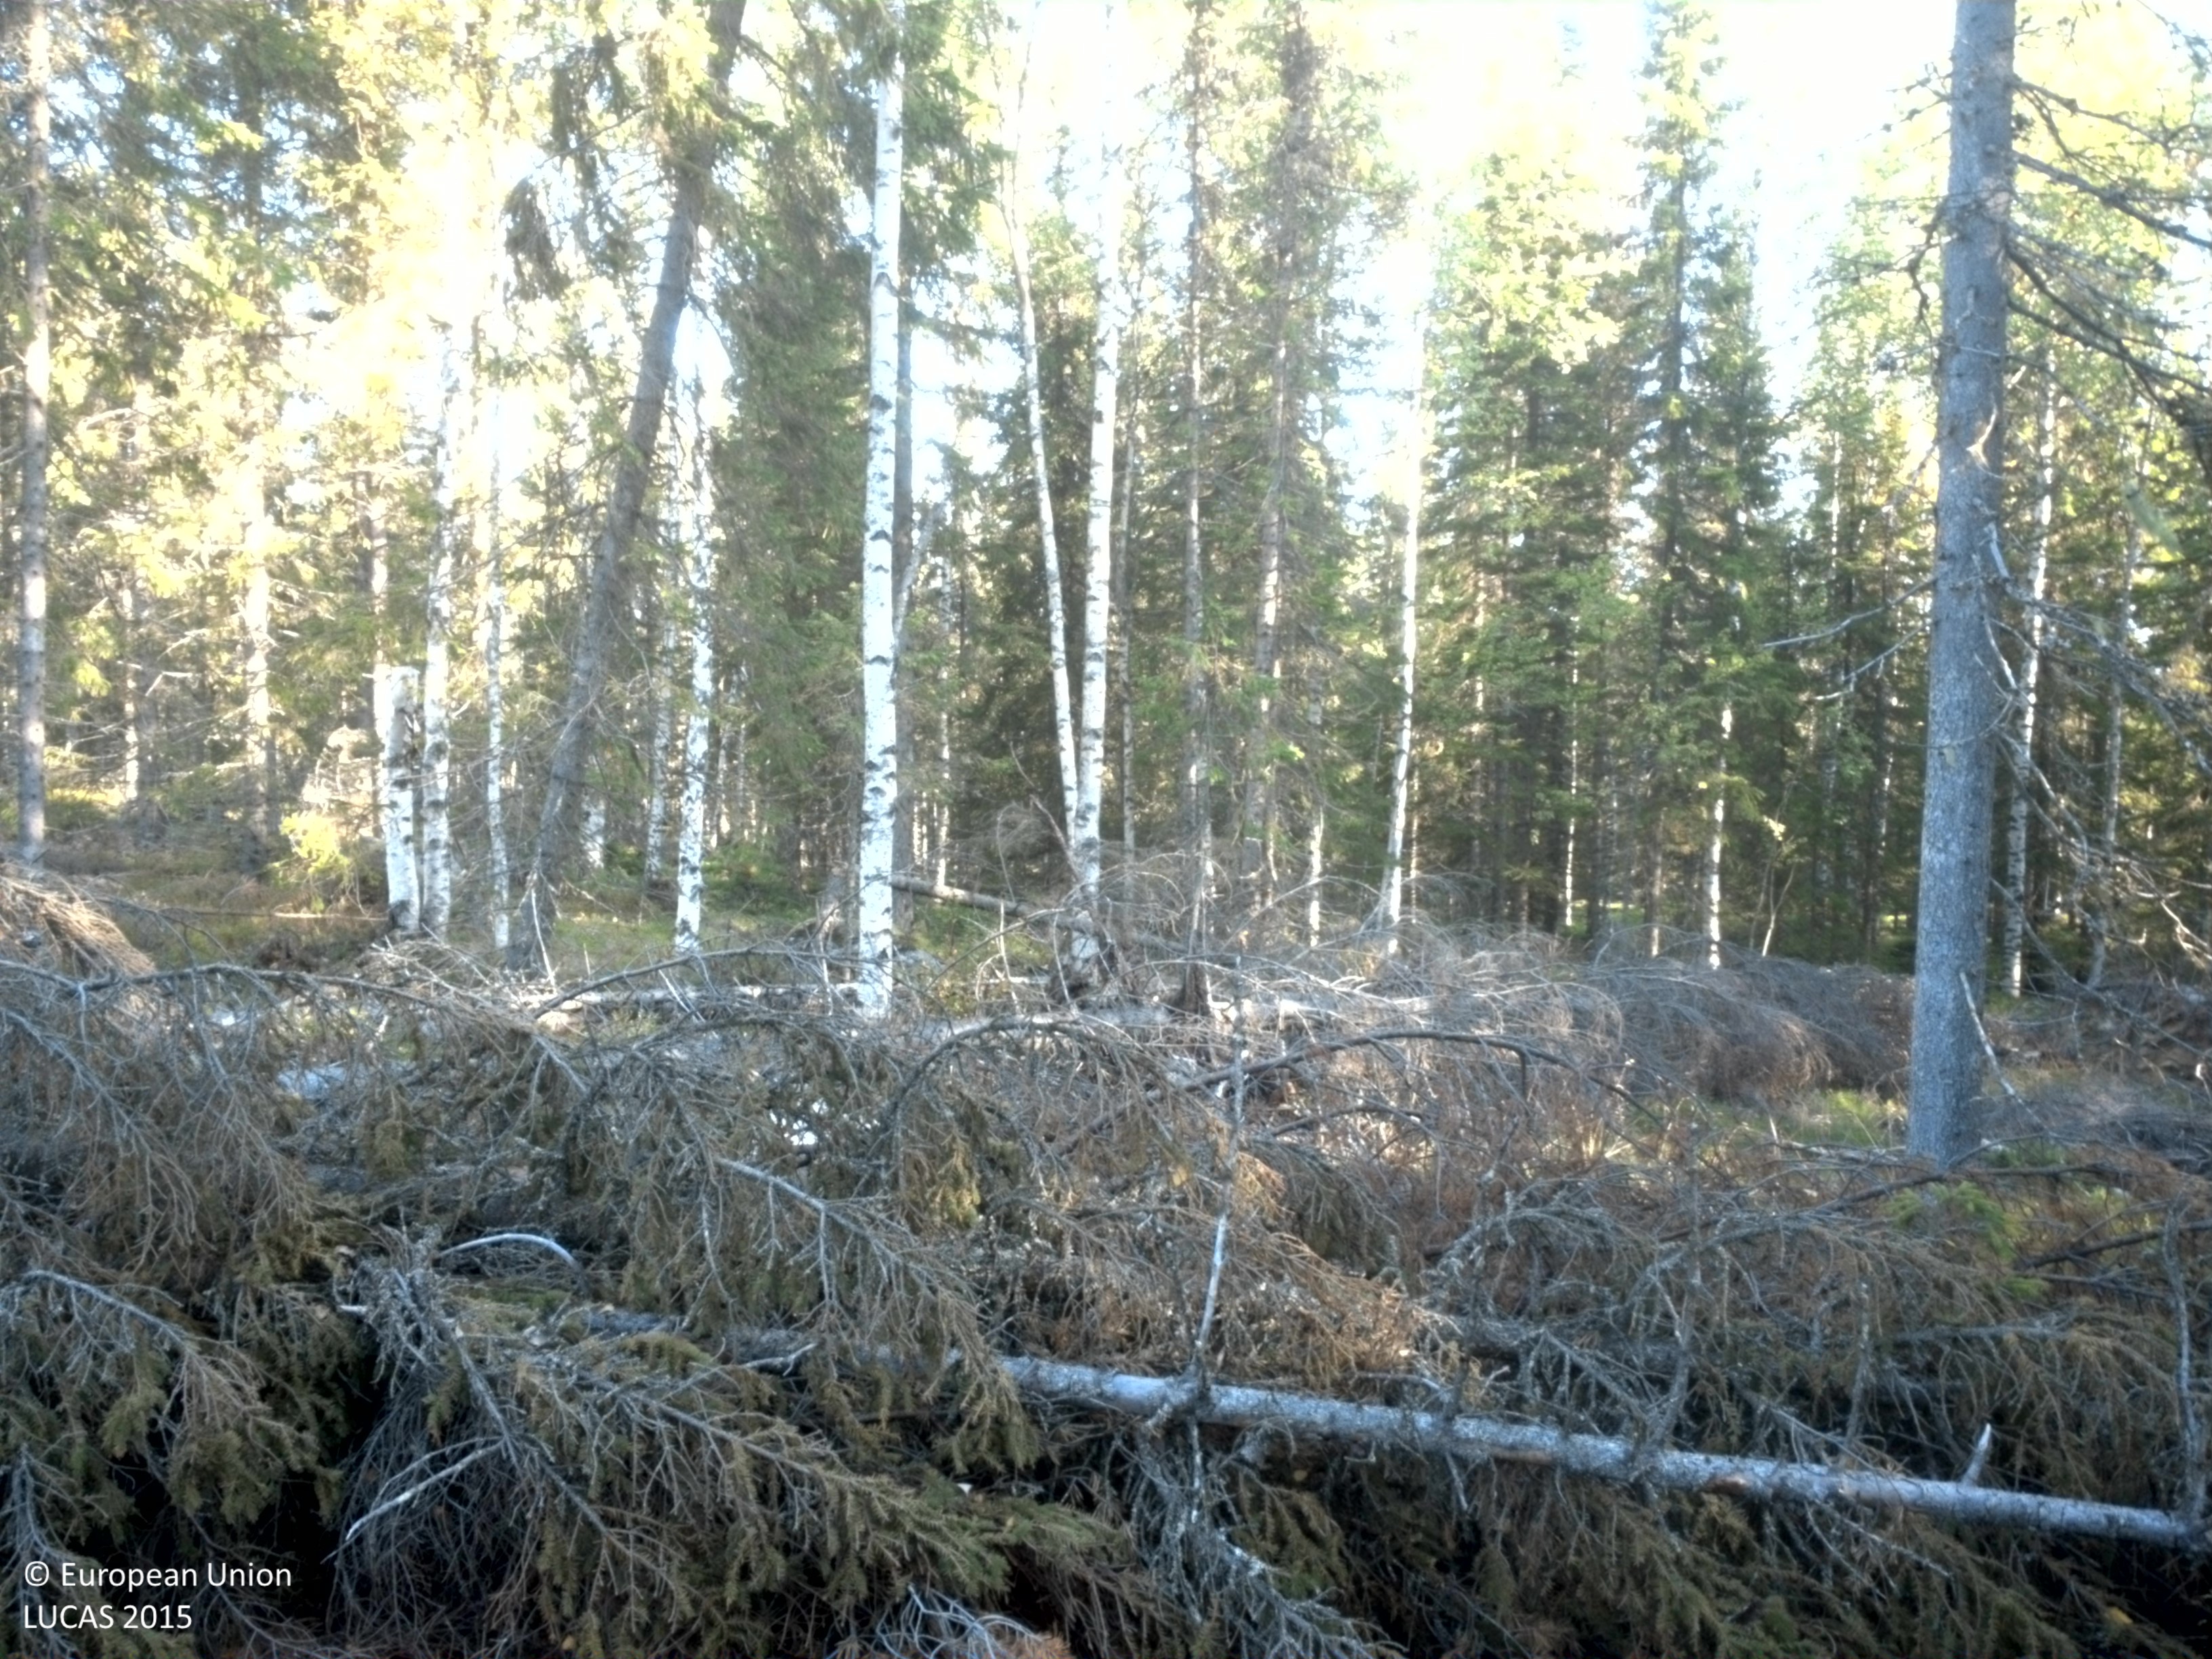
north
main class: Woodland
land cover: Spruce dominated coniferous woodland
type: boreal forest
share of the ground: 50 - 75 %
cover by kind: coniferous forest trees 50 %, shrubs 45 %, broadleaved forest trees 5 %
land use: Forestry
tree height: > 5 m
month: September
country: SE
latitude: 64.3745
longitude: 19.9846
